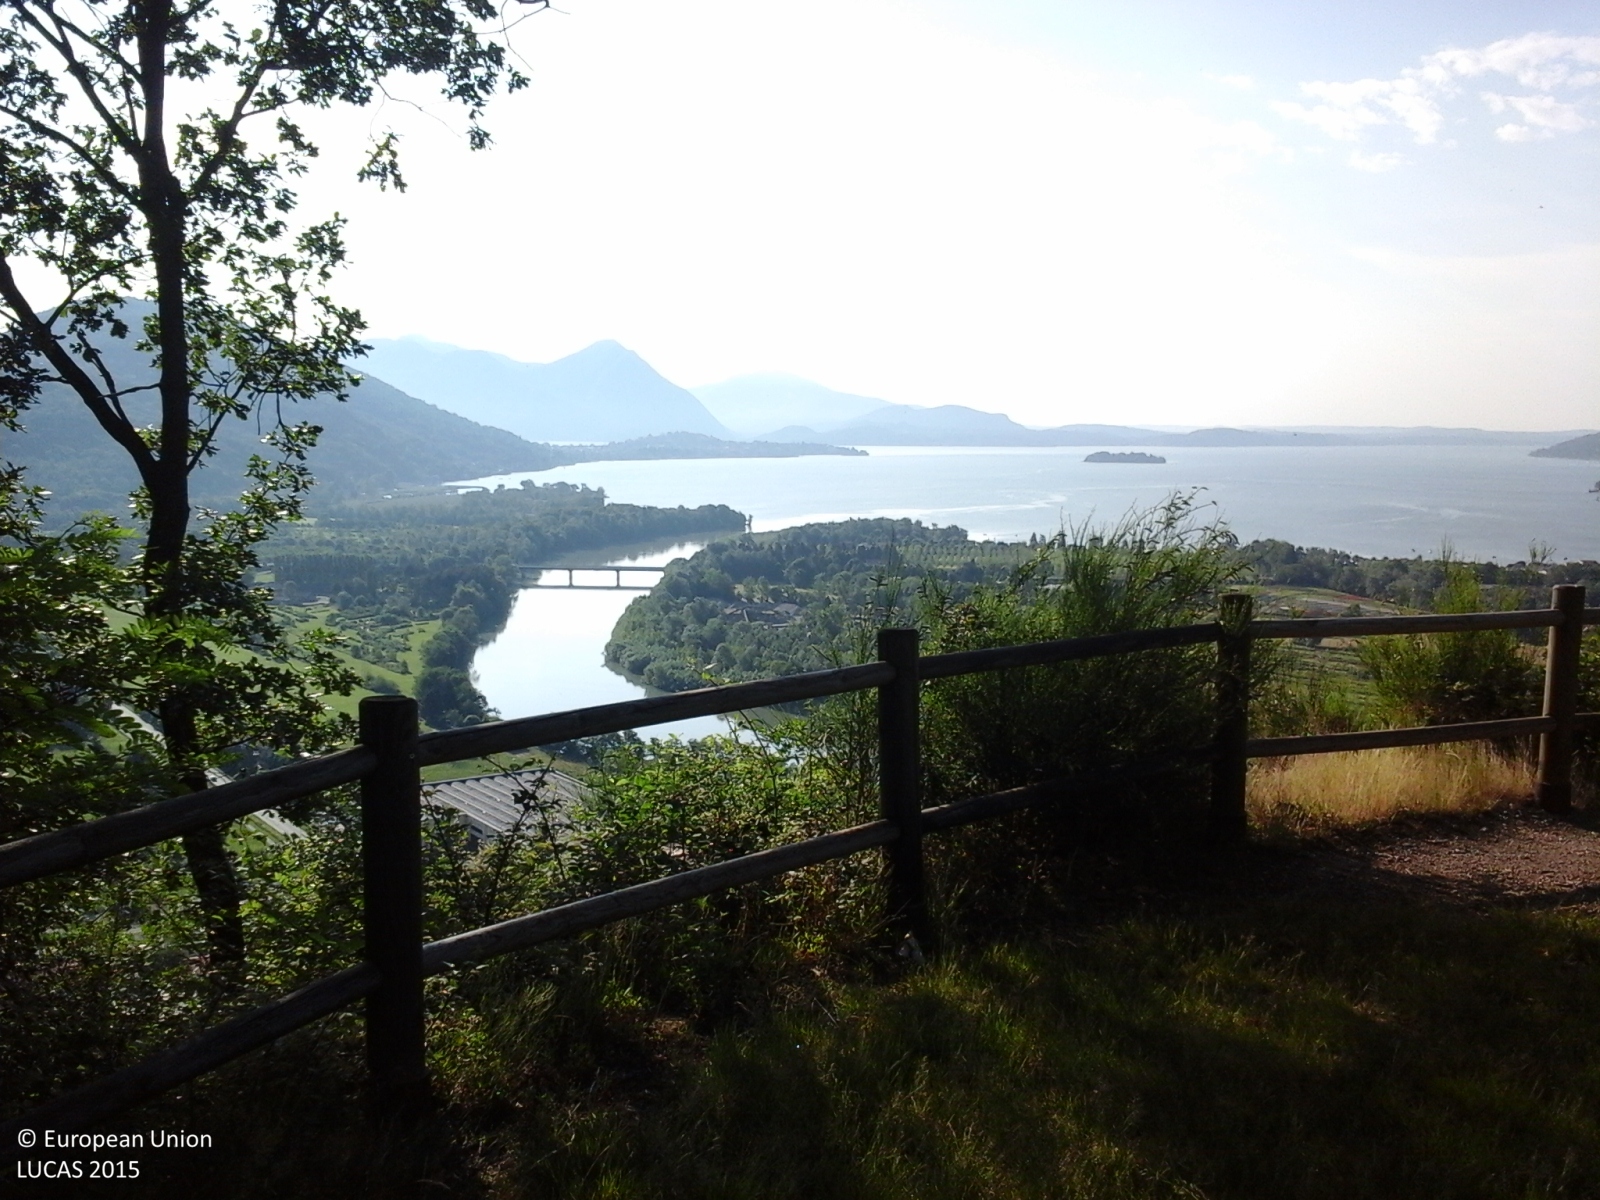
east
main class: Woodland
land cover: Broadleaved woodland
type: mesophytic deciduous forest
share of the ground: > 75 %
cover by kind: broadleaved forest trees 100 %
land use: Forestry
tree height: > 5 m
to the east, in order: Broadleaved woodland; Rocks and stones
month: June
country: IT
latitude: 45.9438
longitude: 8.4672
